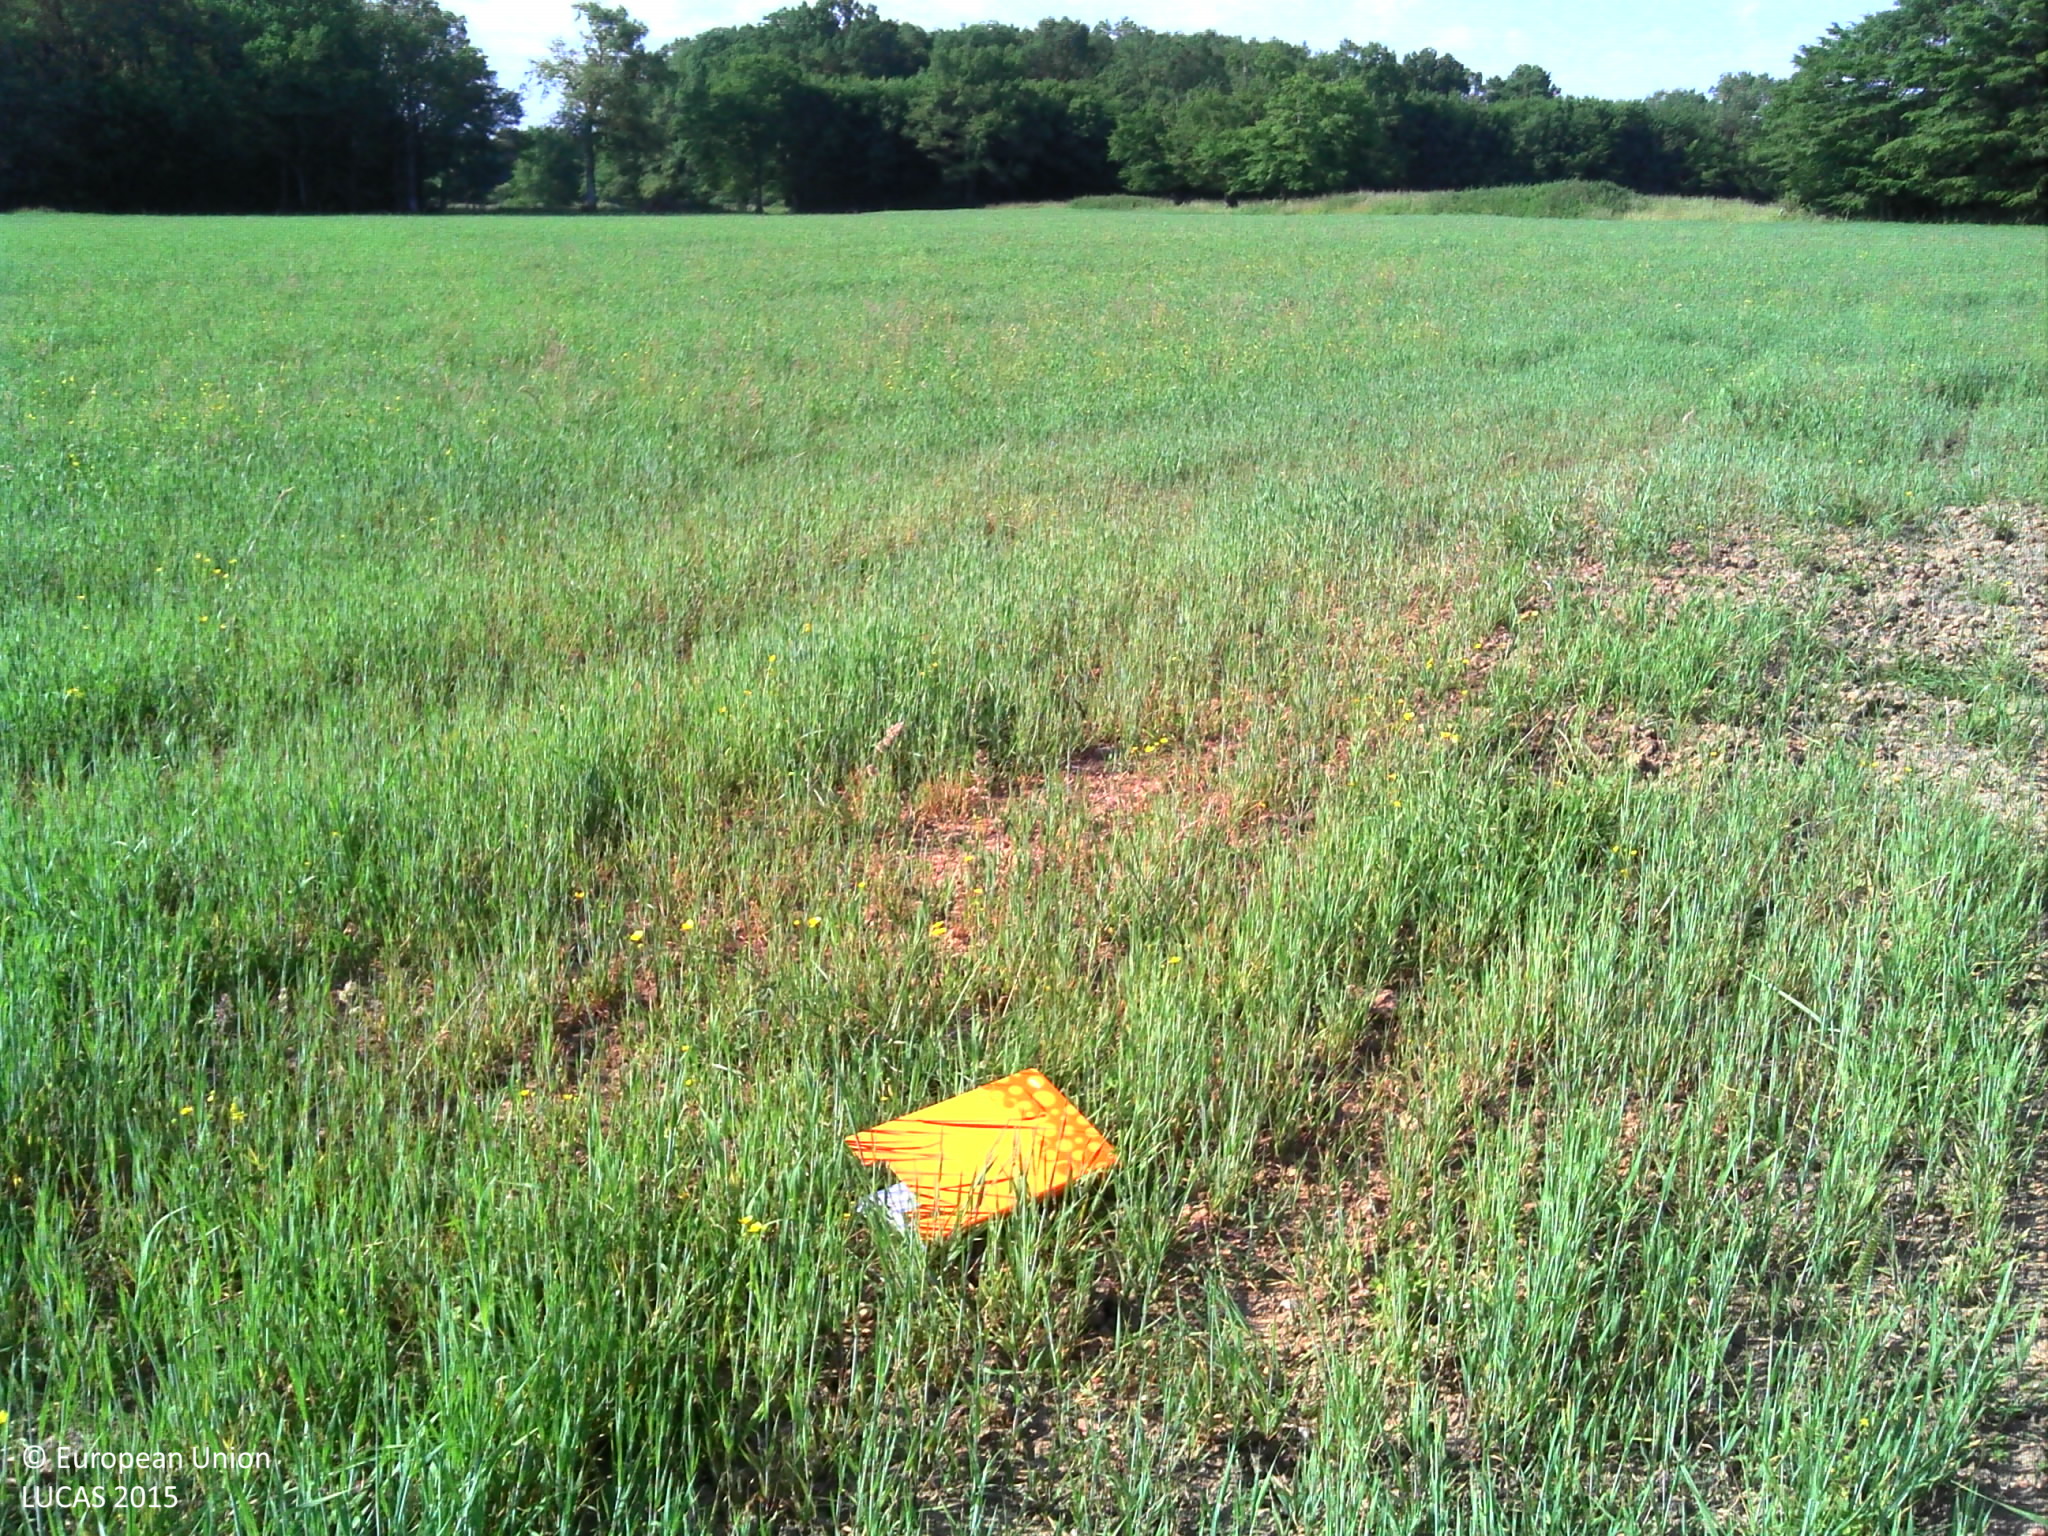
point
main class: Cropland
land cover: Barley
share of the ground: > 75 %
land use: Agriculture (excluding fallow land and kitchen gardens)
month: June
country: FR
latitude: 46.7527
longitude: 2.7035
